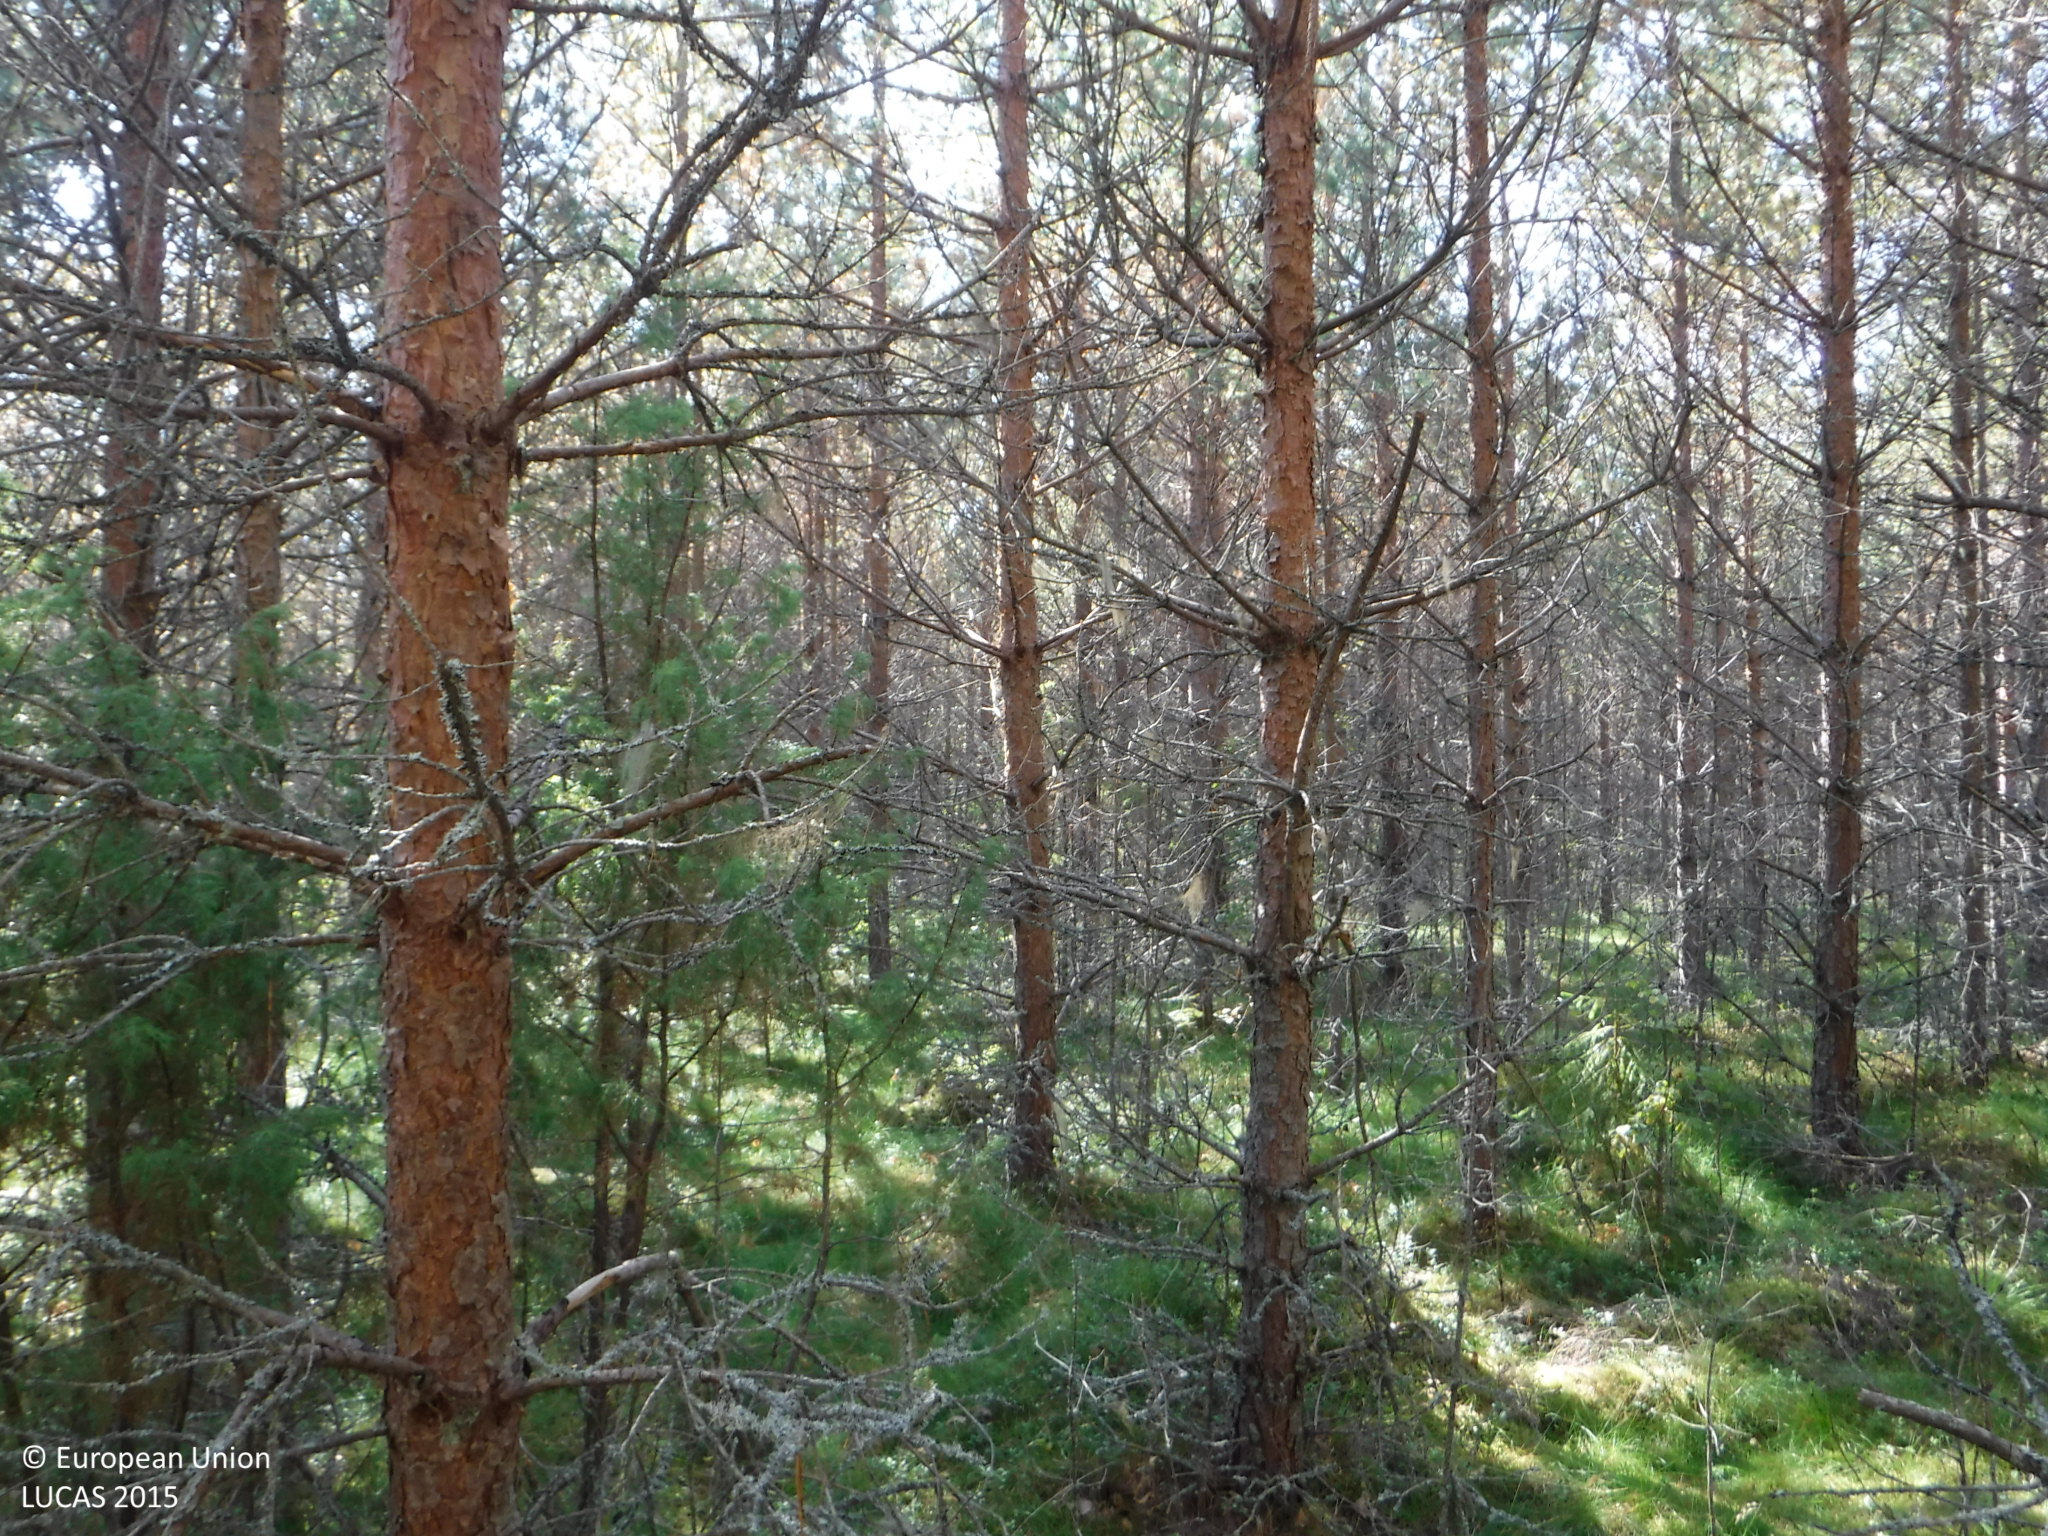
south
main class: Woodland
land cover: Pine dominated coniferous woodland
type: boreal forest
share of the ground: > 75 %
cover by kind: coniferous forest trees 75 %, herbaceous plants 25 %
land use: Forestry
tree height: > 5 m
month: September
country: FI
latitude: 61.7687
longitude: 22.8197
